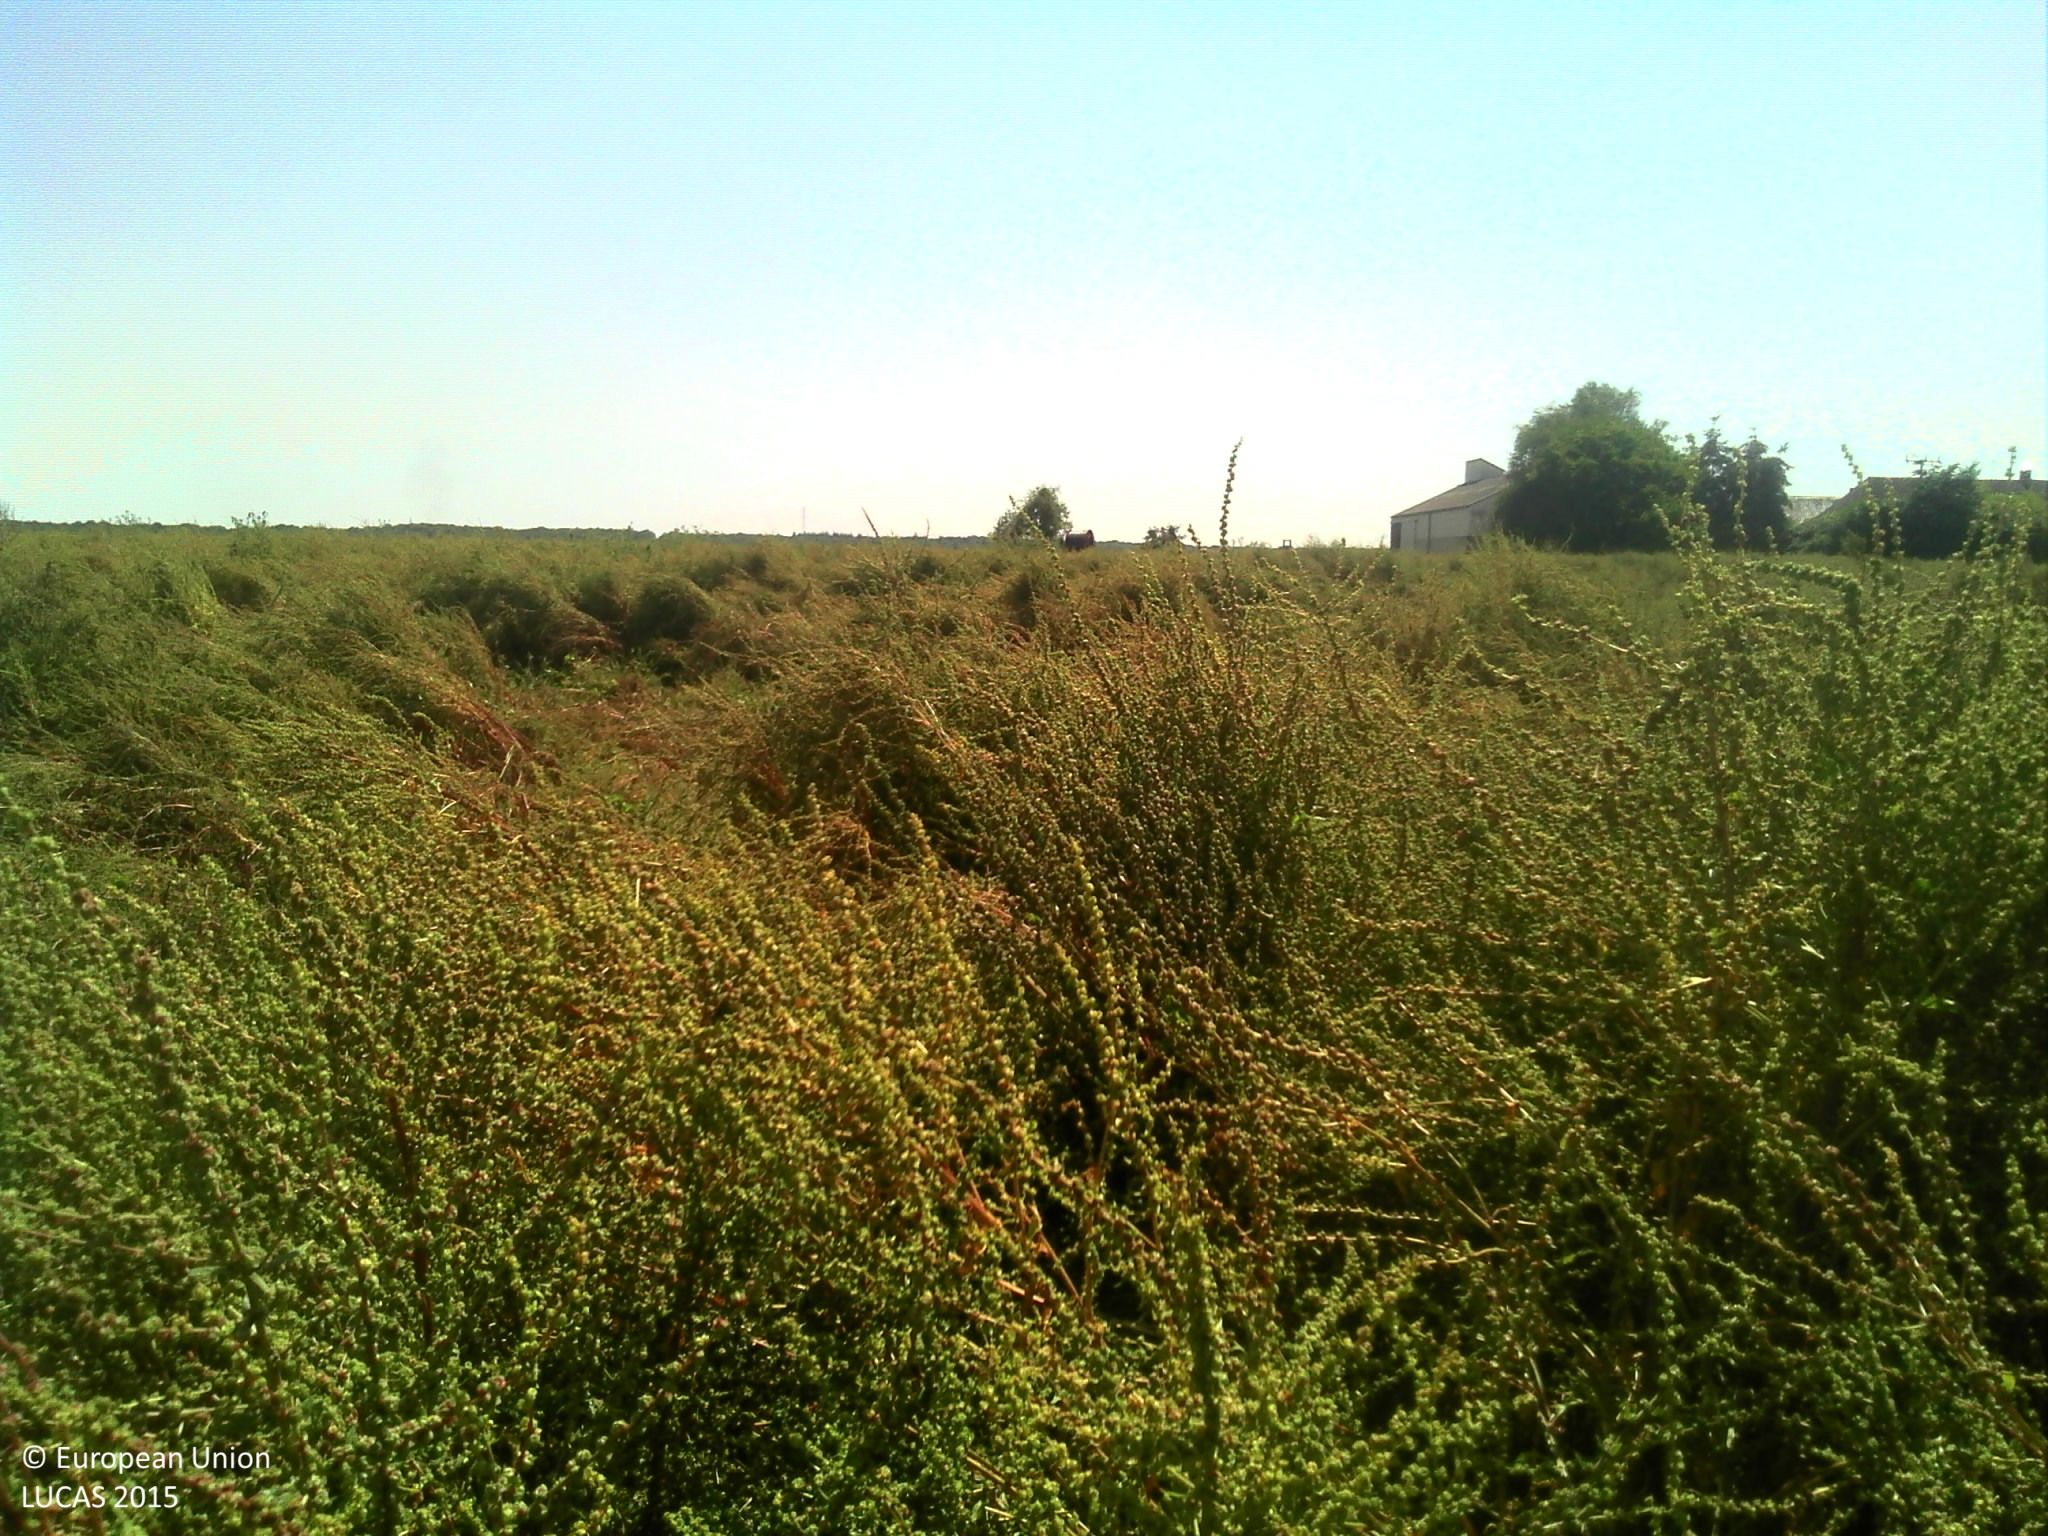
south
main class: Cropland
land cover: Sugar beet
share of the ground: > 75 %
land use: Agriculture (excluding fallow land and kitchen gardens)
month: July
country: FR
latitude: 48.2030
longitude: 1.2767
